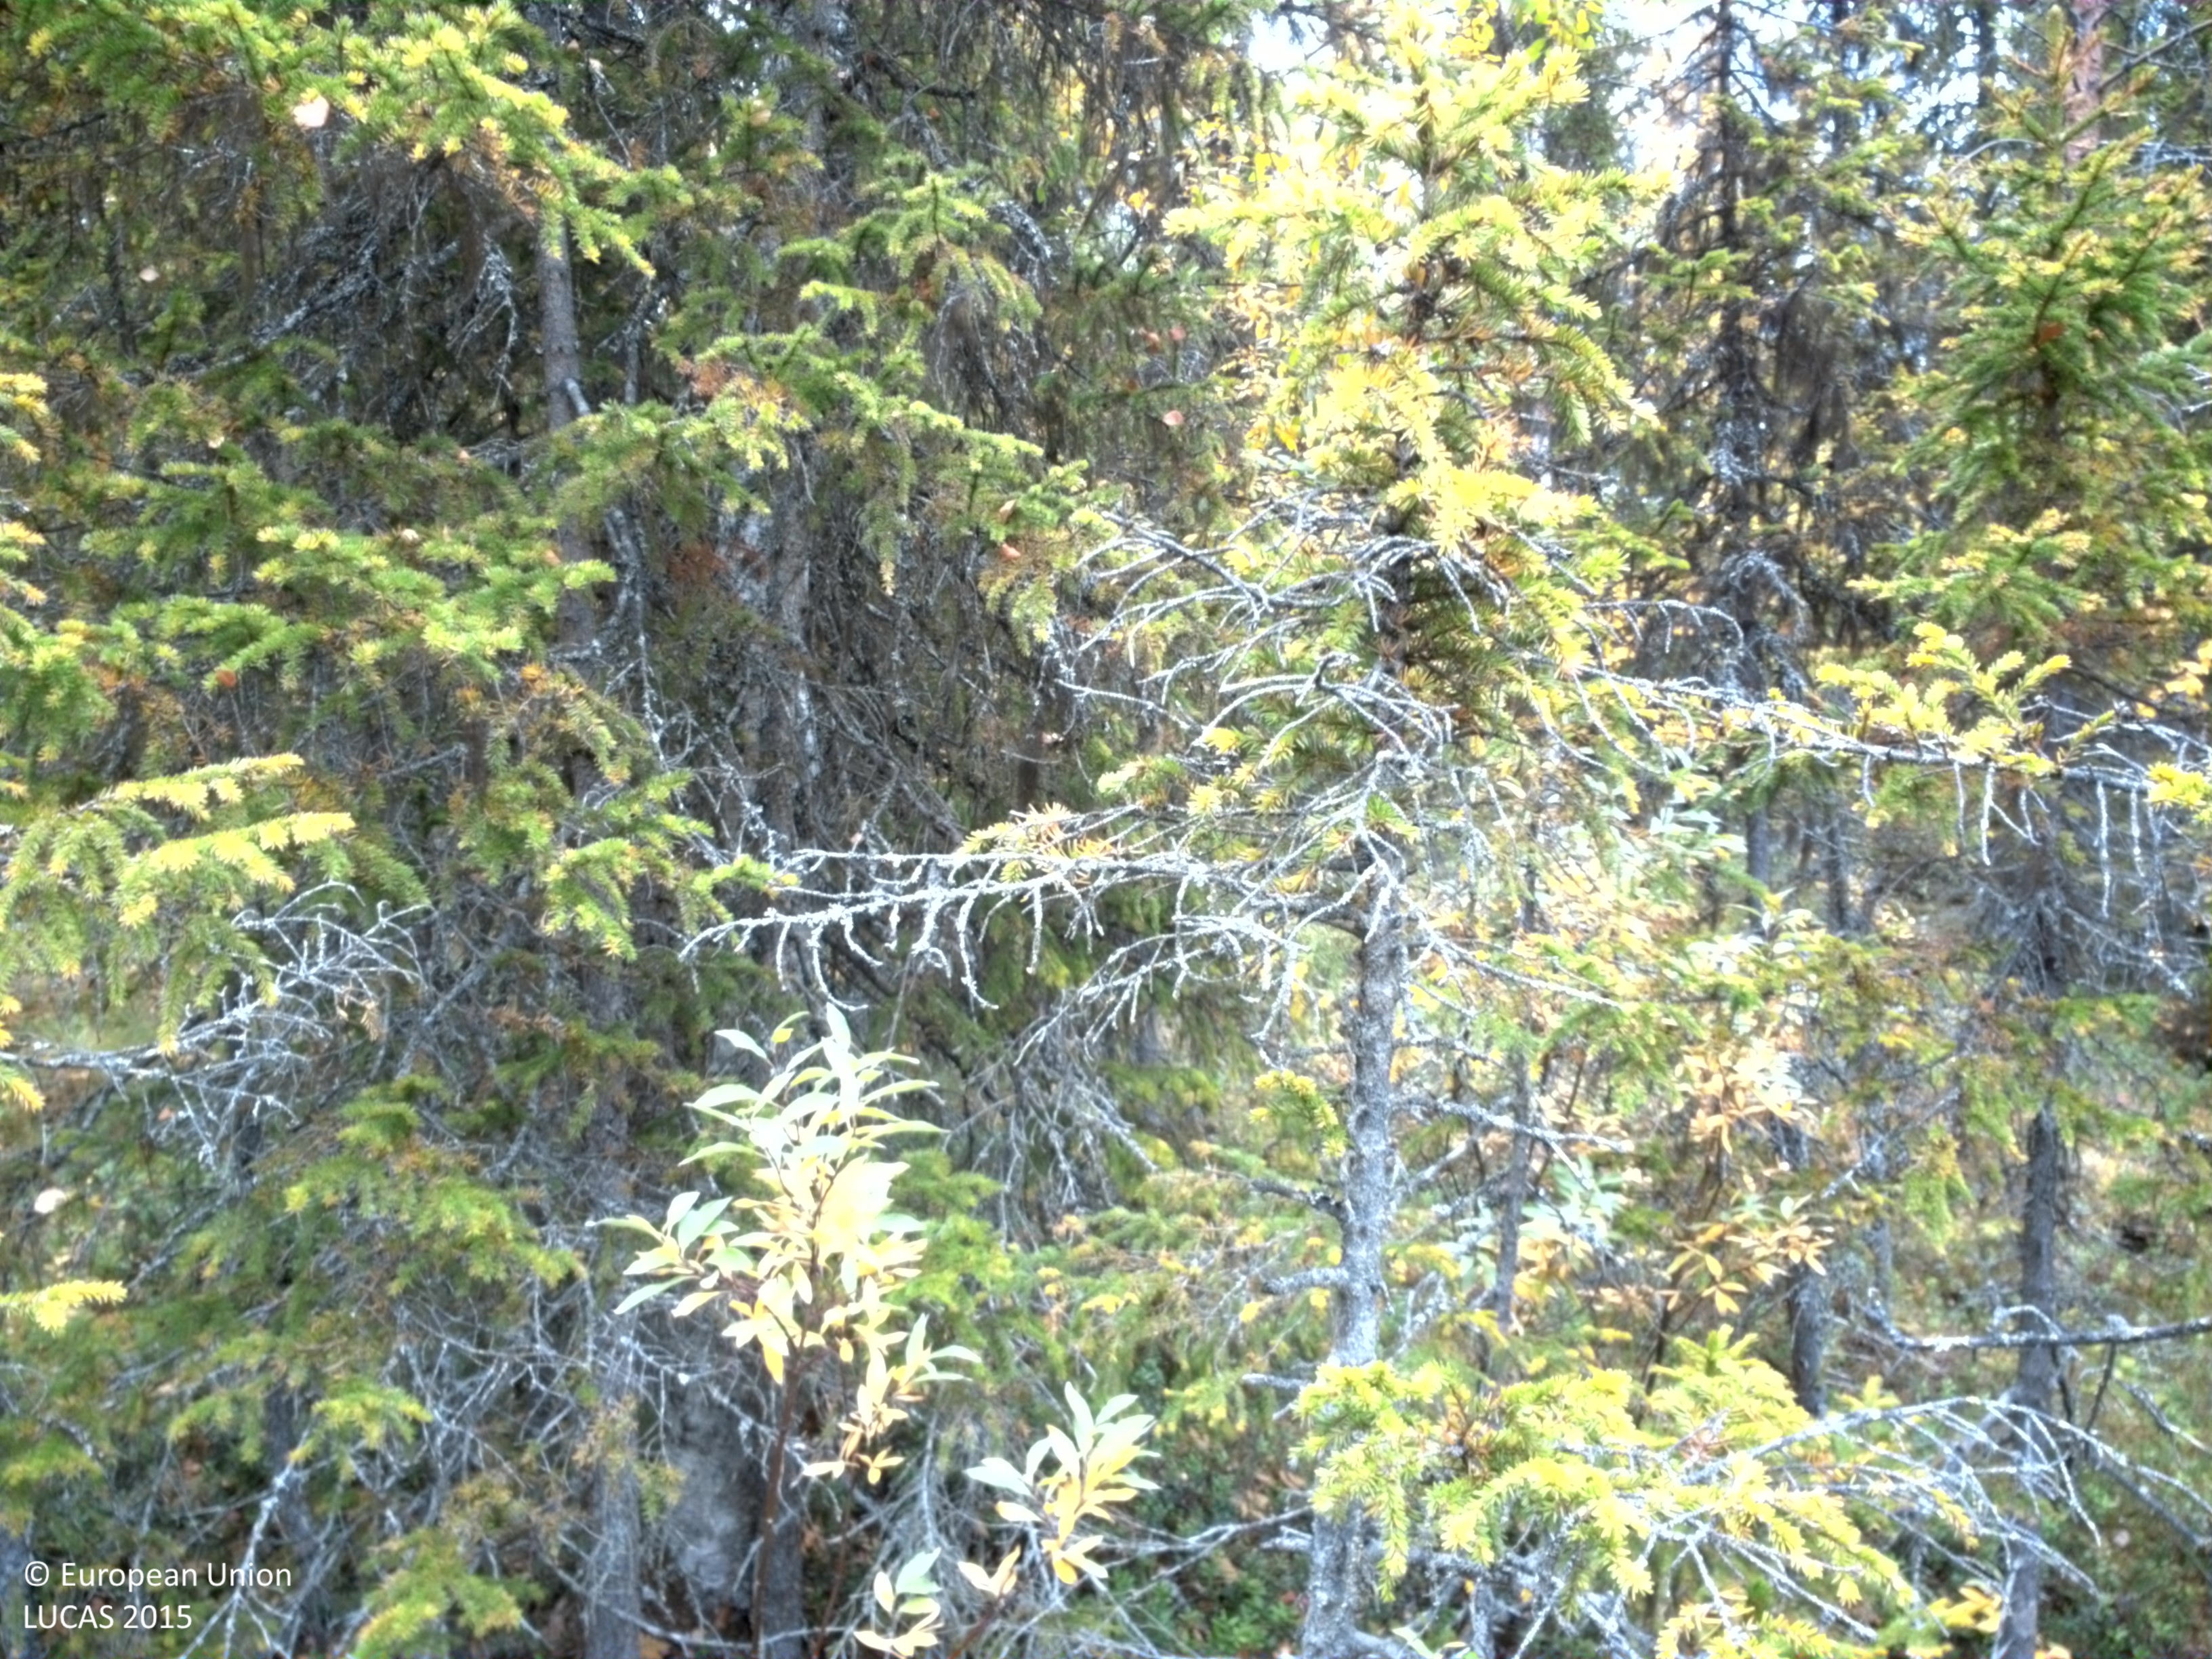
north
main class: Woodland
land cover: Spruce dominated coniferous woodland
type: boreal forest
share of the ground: 25 - 50 %
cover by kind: shrubs 40 %, coniferous forest trees 35 %, lichens and mosses 15 %, broadleaved forest trees 5 %, herbaceous plants 5 %
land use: Forestry
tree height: > 5 m
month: September
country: SE
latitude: 65.1176
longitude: 16.9284
